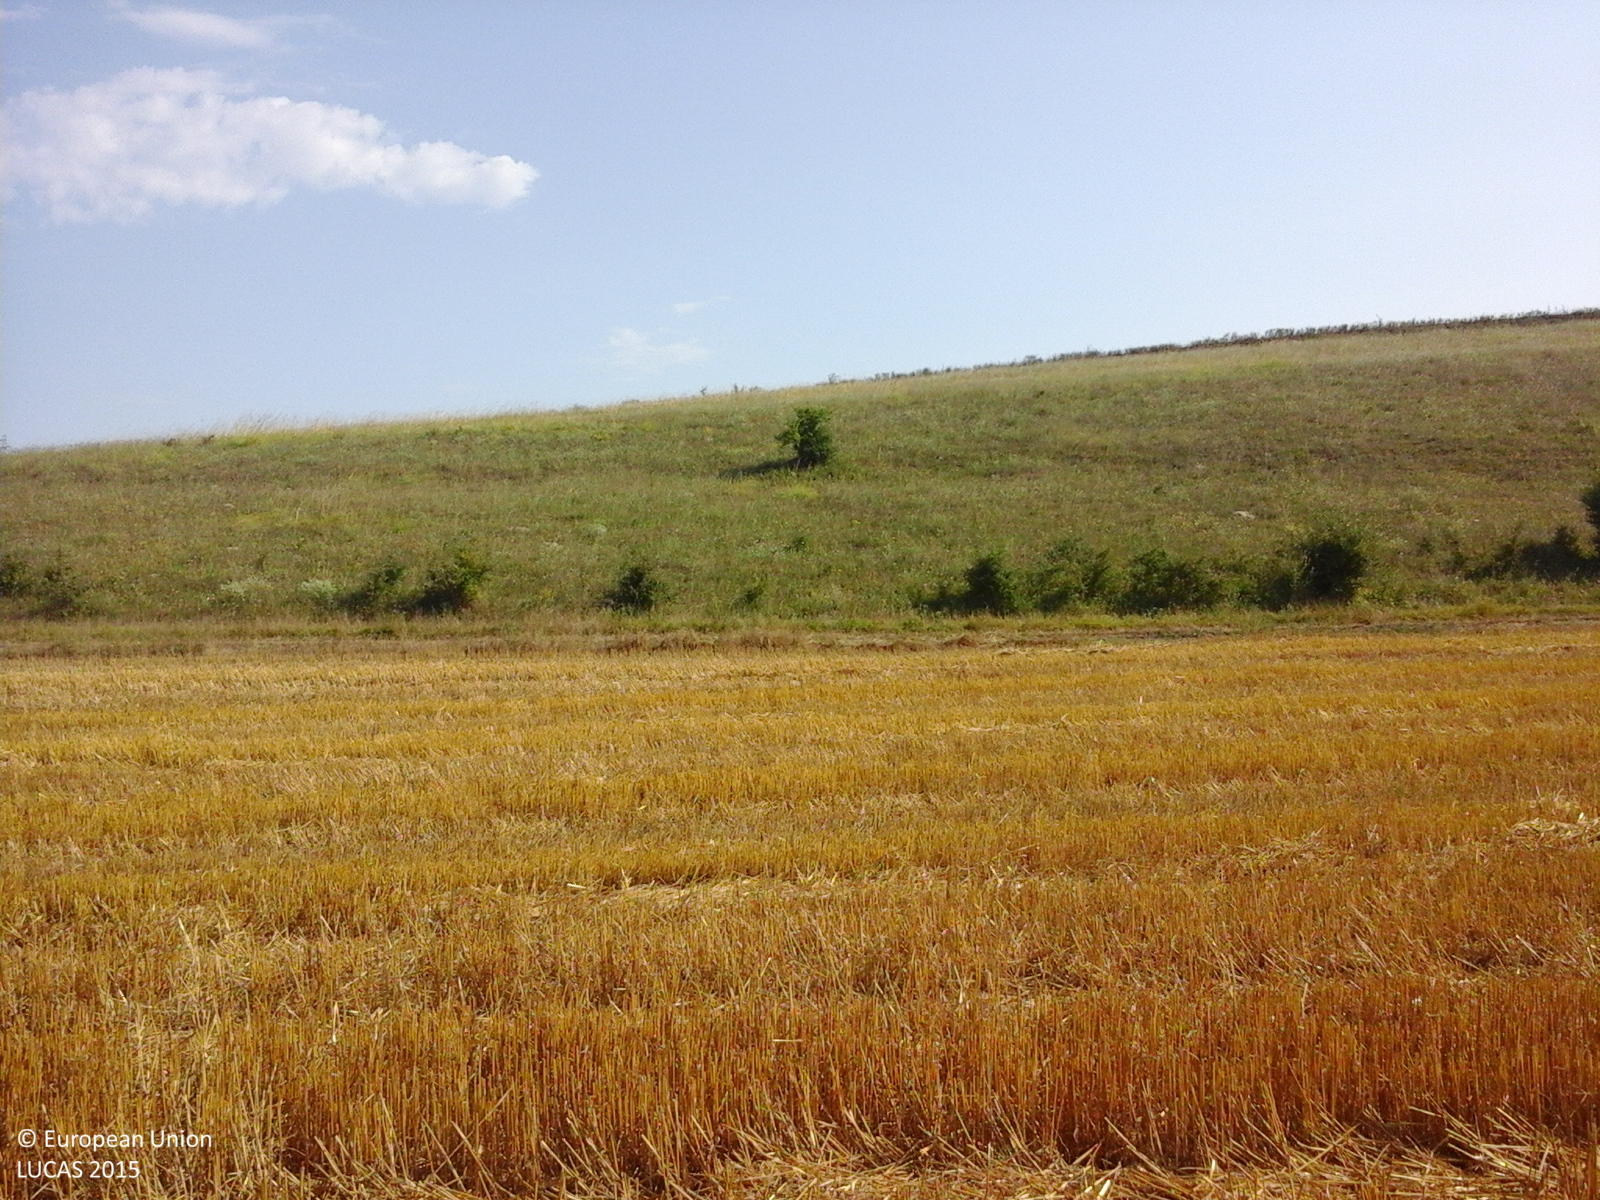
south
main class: Cropland
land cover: Common wheat
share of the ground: > 75 %
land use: Agriculture (excluding fallow land and kitchen gardens)
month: August
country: RO
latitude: 44.0842
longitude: 28.0248
